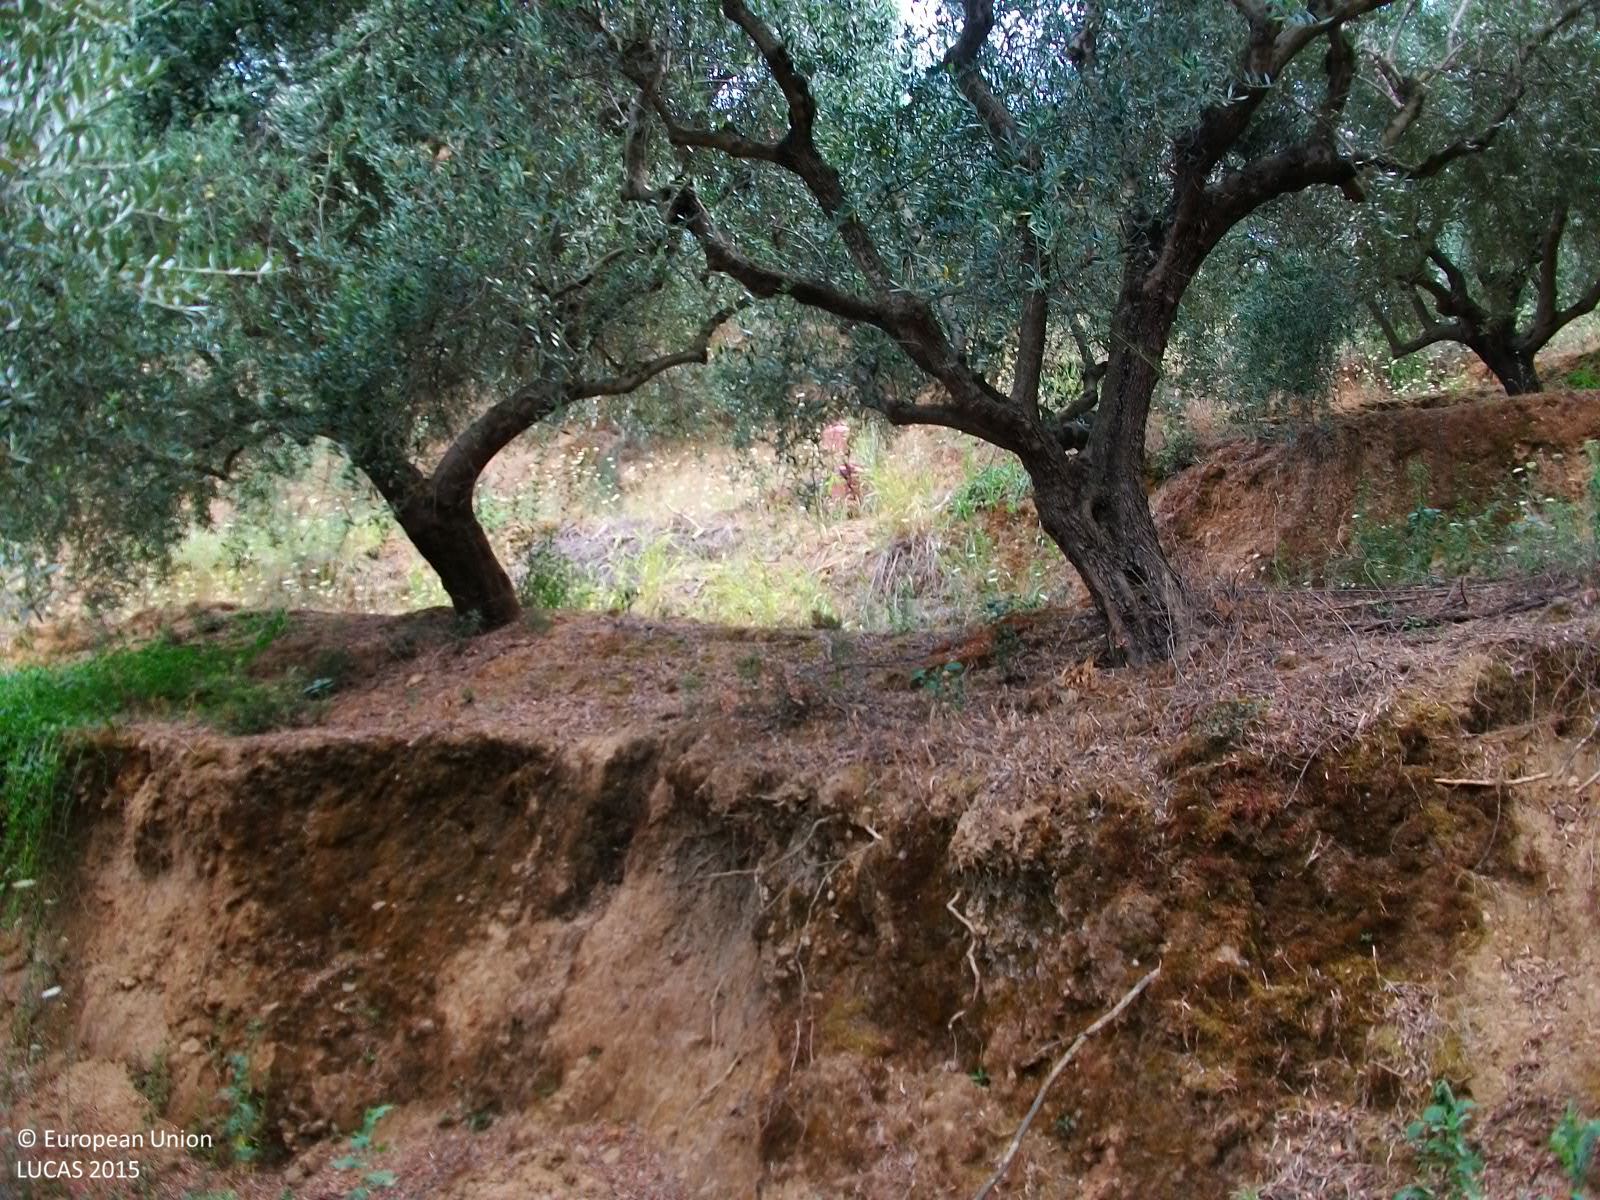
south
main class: Cropland
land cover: Olive groves
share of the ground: 50 - 75 %
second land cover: Spontaneously vegetated surfaces
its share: > 75 %
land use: Agriculture (excluding fallow land and kitchen gardens)
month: July
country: GR
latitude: 37.0819
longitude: 21.9561
